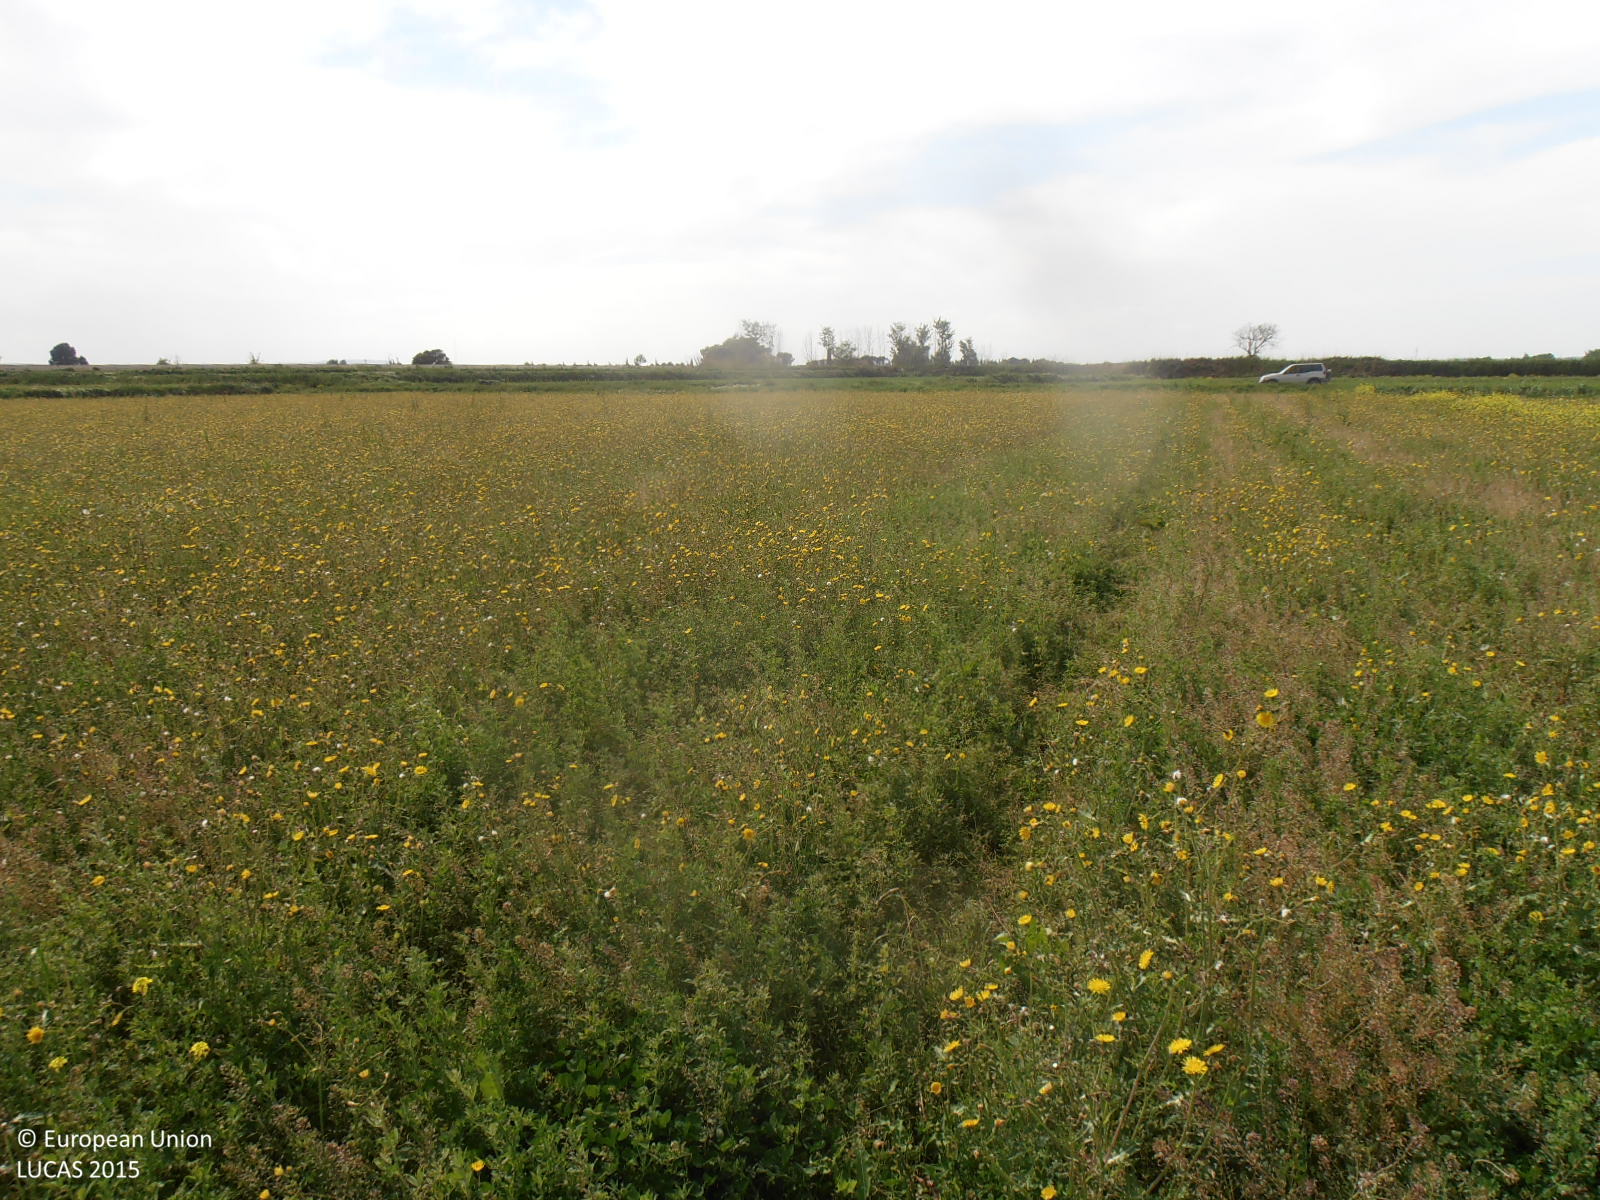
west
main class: Cropland
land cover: Lucerne
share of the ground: > 75 %
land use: Agriculture (excluding fallow land and kitchen gardens)
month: April
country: ES
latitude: 41.6390
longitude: -0.7896
